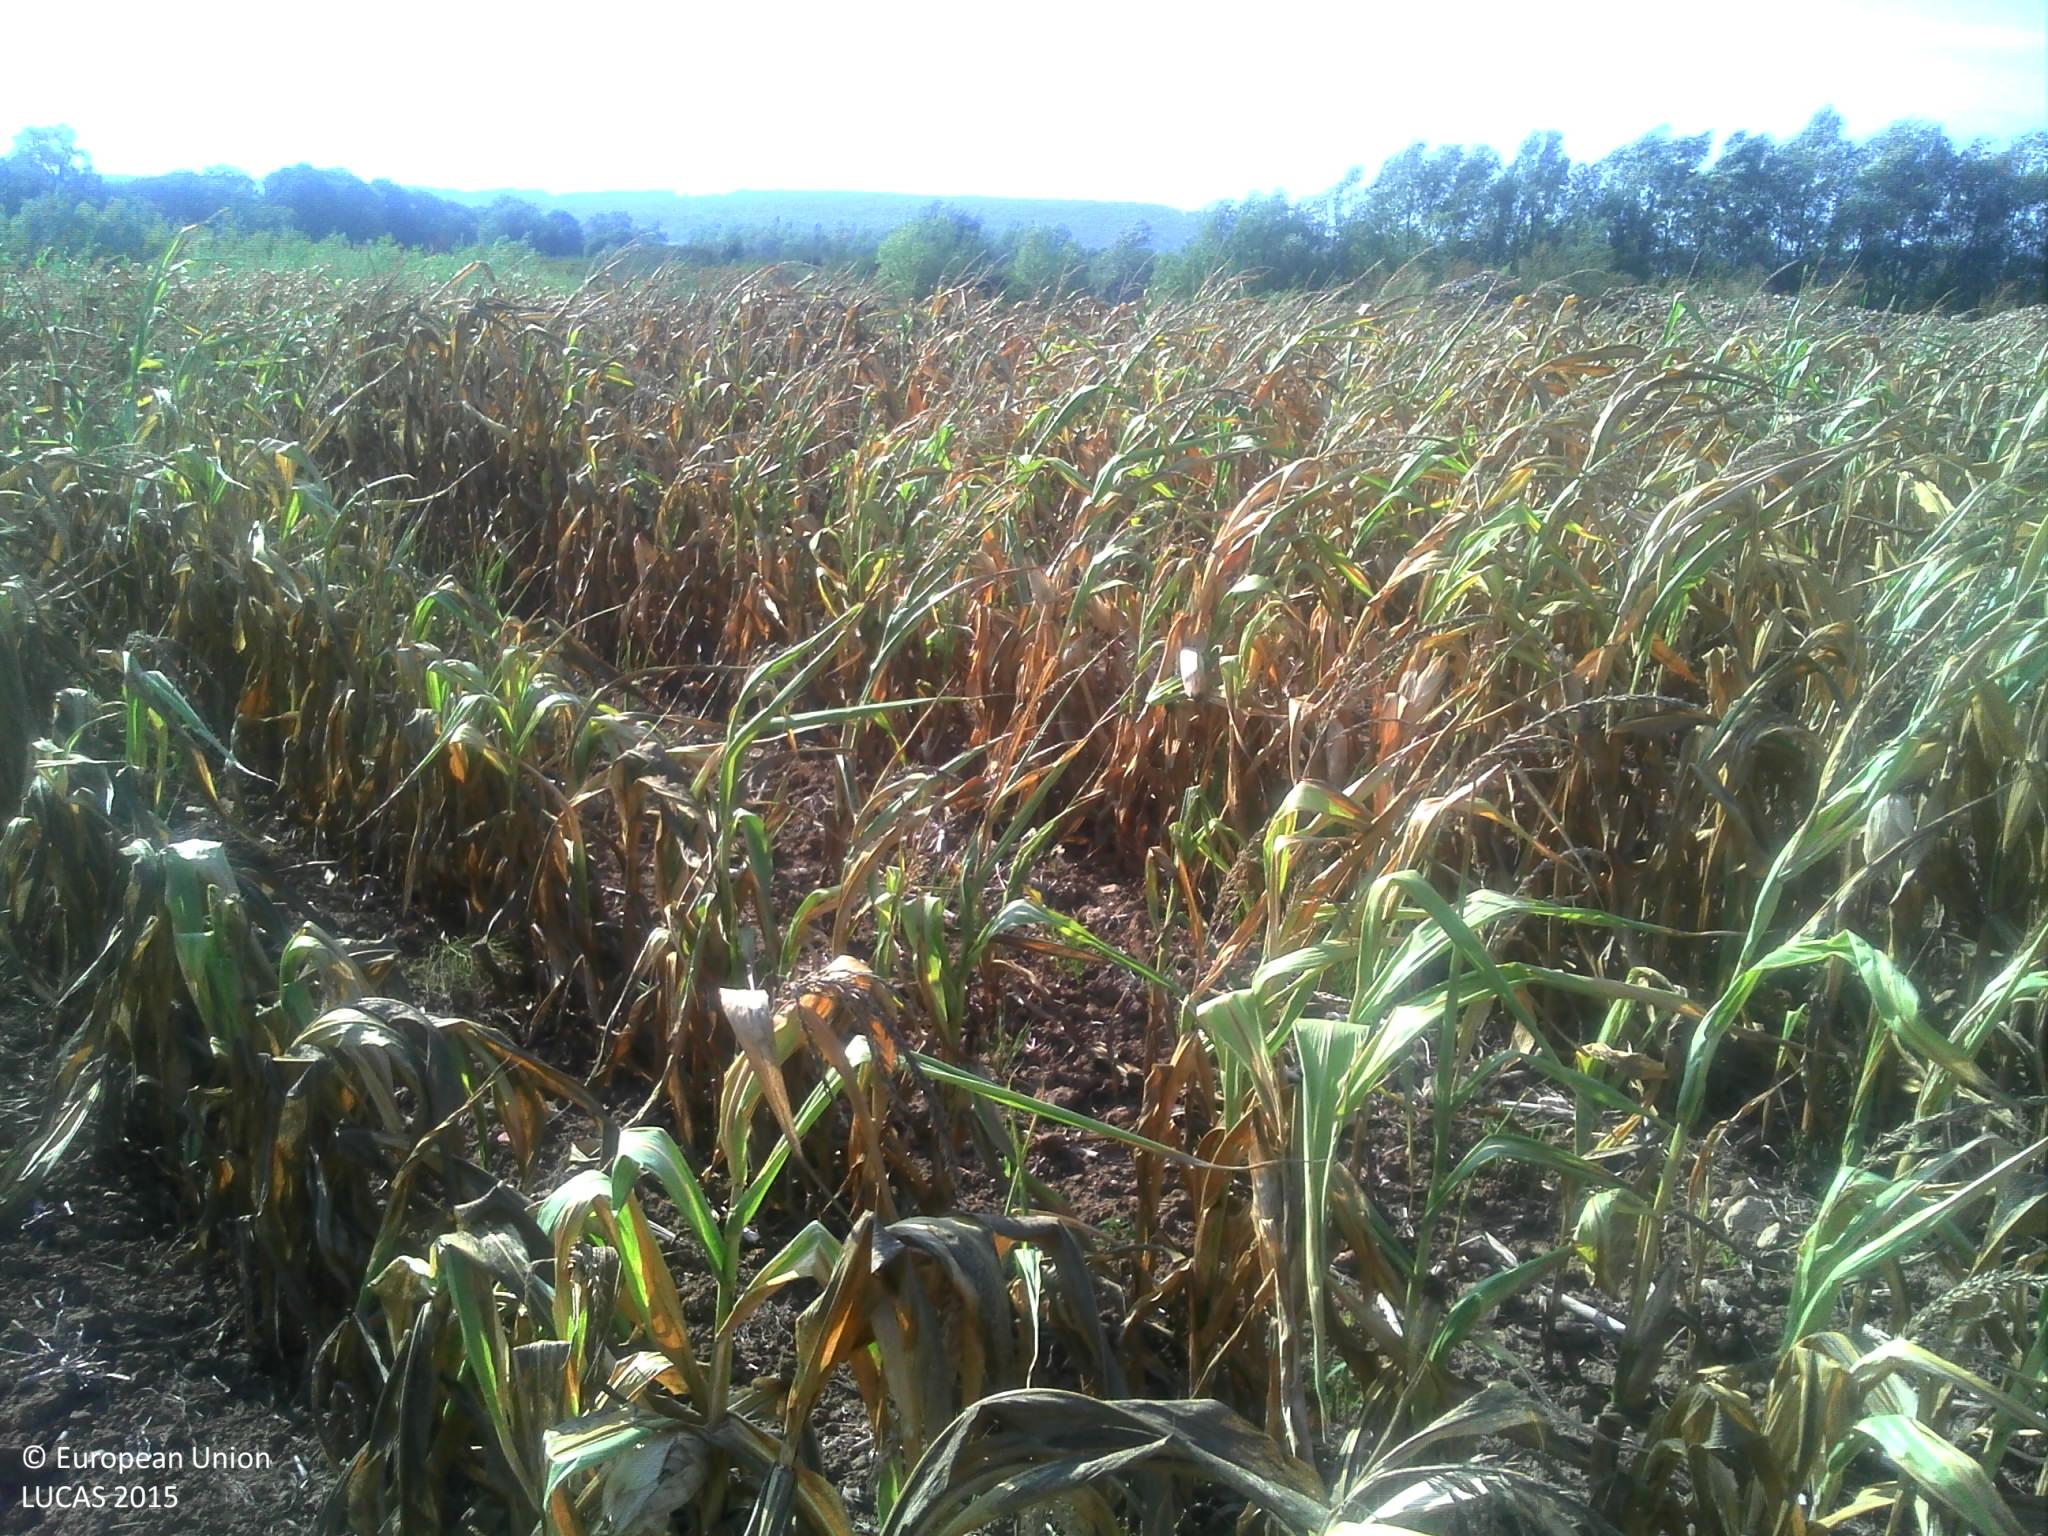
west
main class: Cropland
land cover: Maize
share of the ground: > 75 %
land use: Agriculture (excluding fallow land and kitchen gardens)
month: August
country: FR
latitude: 48.8746
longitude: 6.0866
